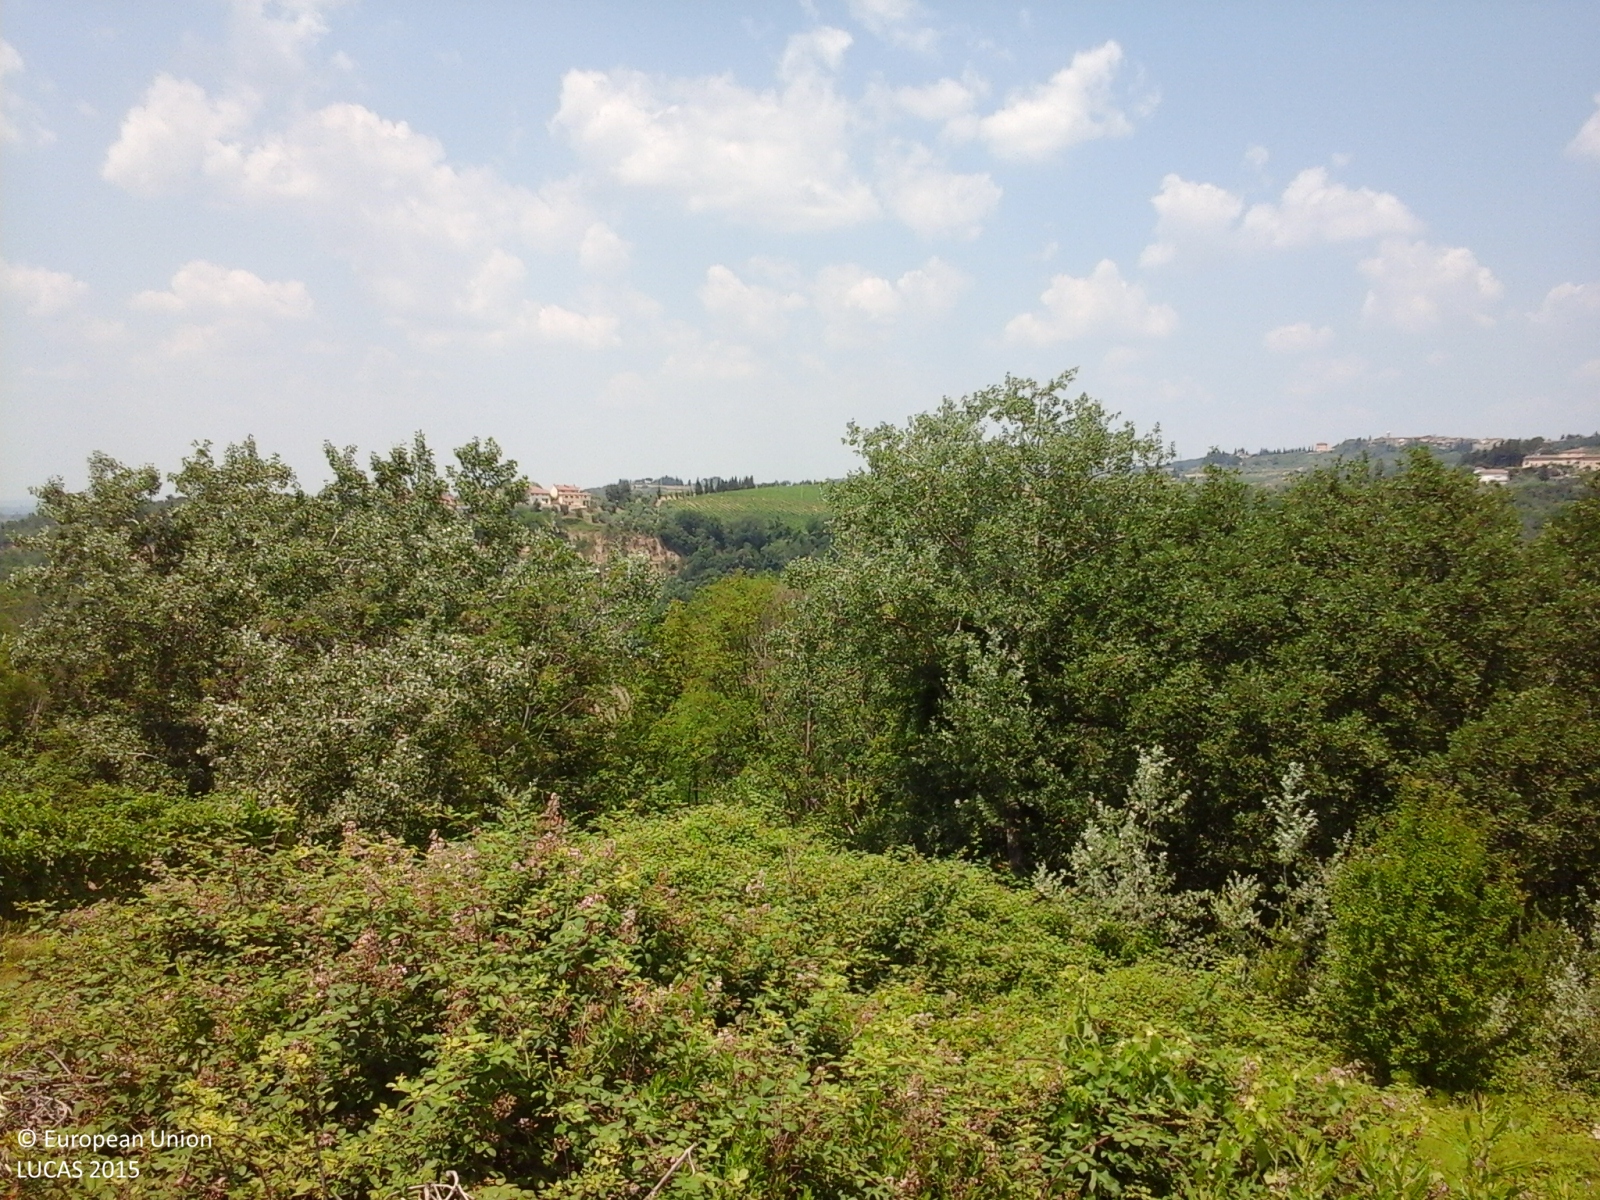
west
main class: Cropland
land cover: Vineyards
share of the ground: 25 - 50 %
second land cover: Grassland without tree/shrub cover
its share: > 75 %
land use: Agriculture (excluding fallow land and kitchen gardens)
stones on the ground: < 10 %
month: June
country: IT
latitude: 43.5503
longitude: 11.1480
